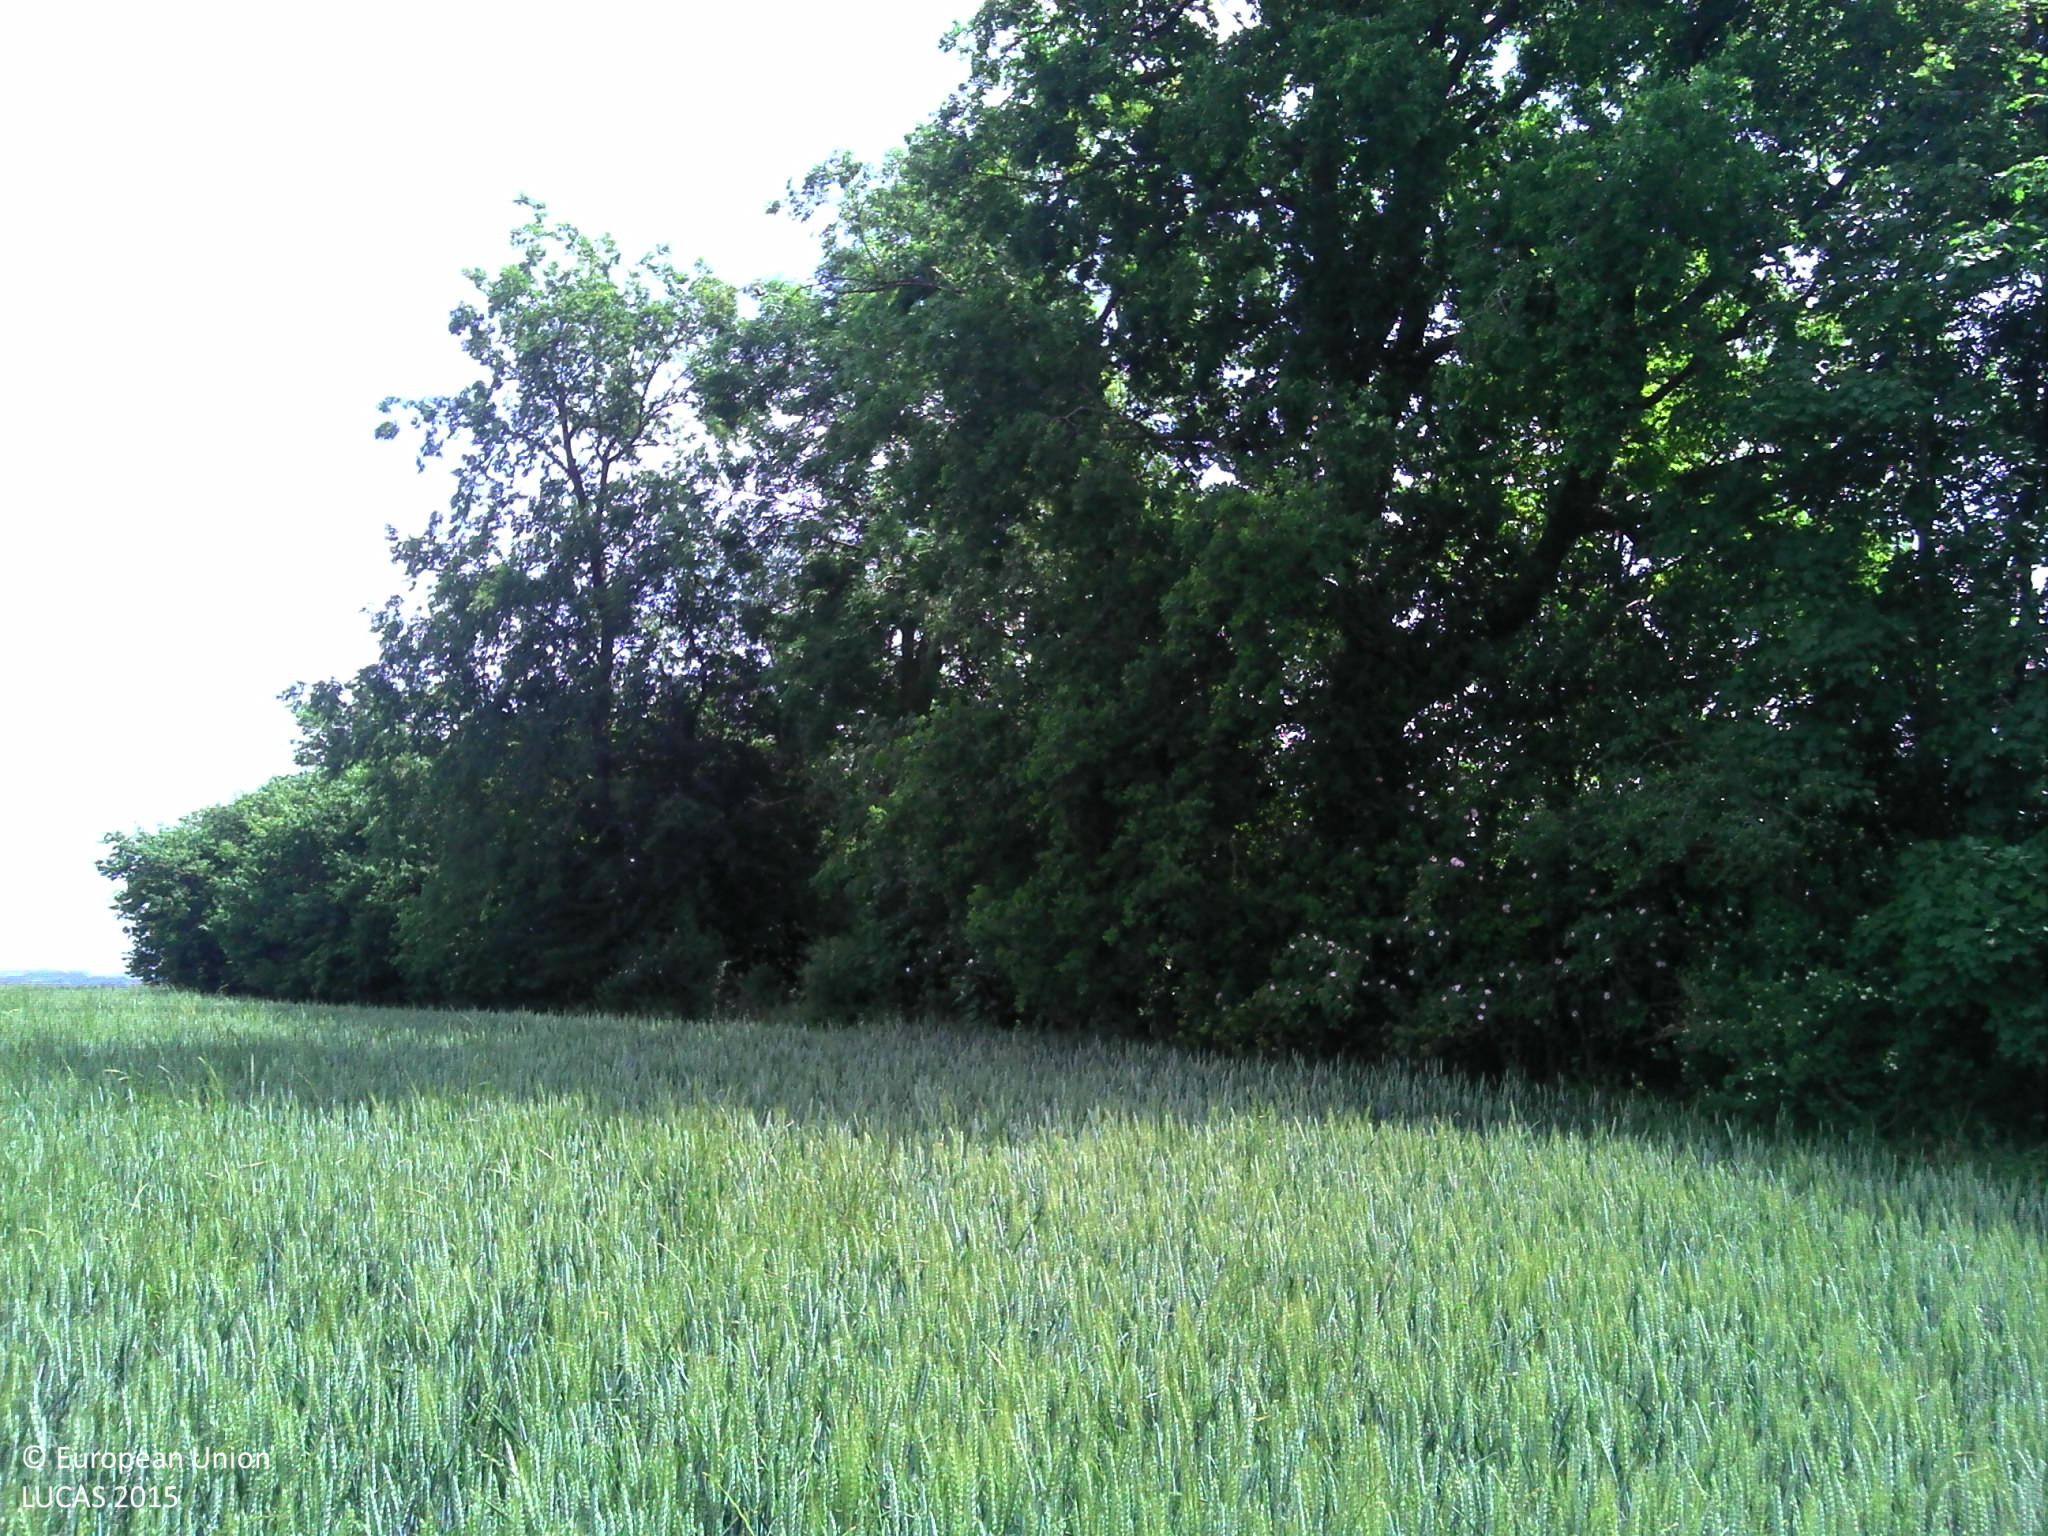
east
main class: Cropland
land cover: Common wheat
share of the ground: > 75 %
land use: Agriculture (excluding fallow land and kitchen gardens)
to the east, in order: Common wheat; Broadleaved woodland; Maize; Broadleaved woodland; Common wheat
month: June
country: FR
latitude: 49.5959
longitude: 2.5309
